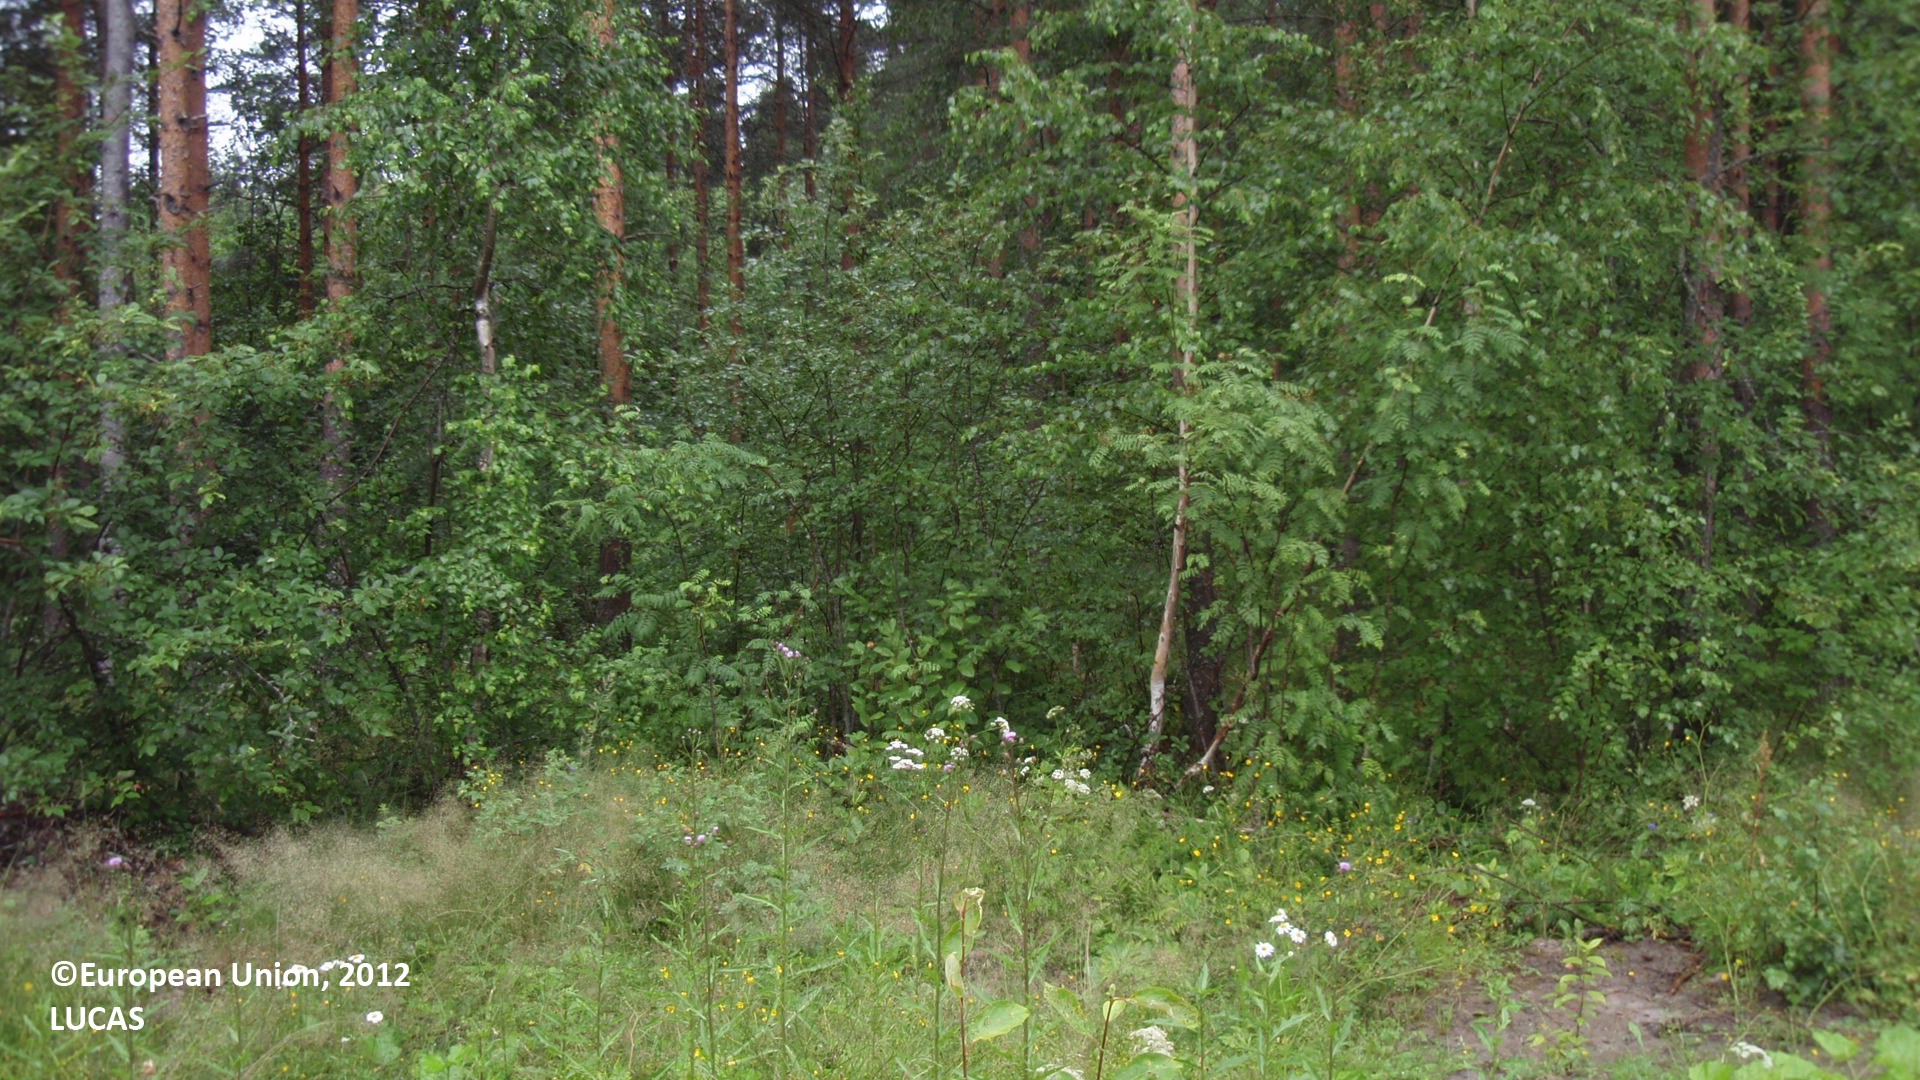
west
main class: Grassland
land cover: Spontaneously vegetated surfaces
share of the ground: > 75 %
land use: Forestry
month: July
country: FI
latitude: 61.1112
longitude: 28.8012
